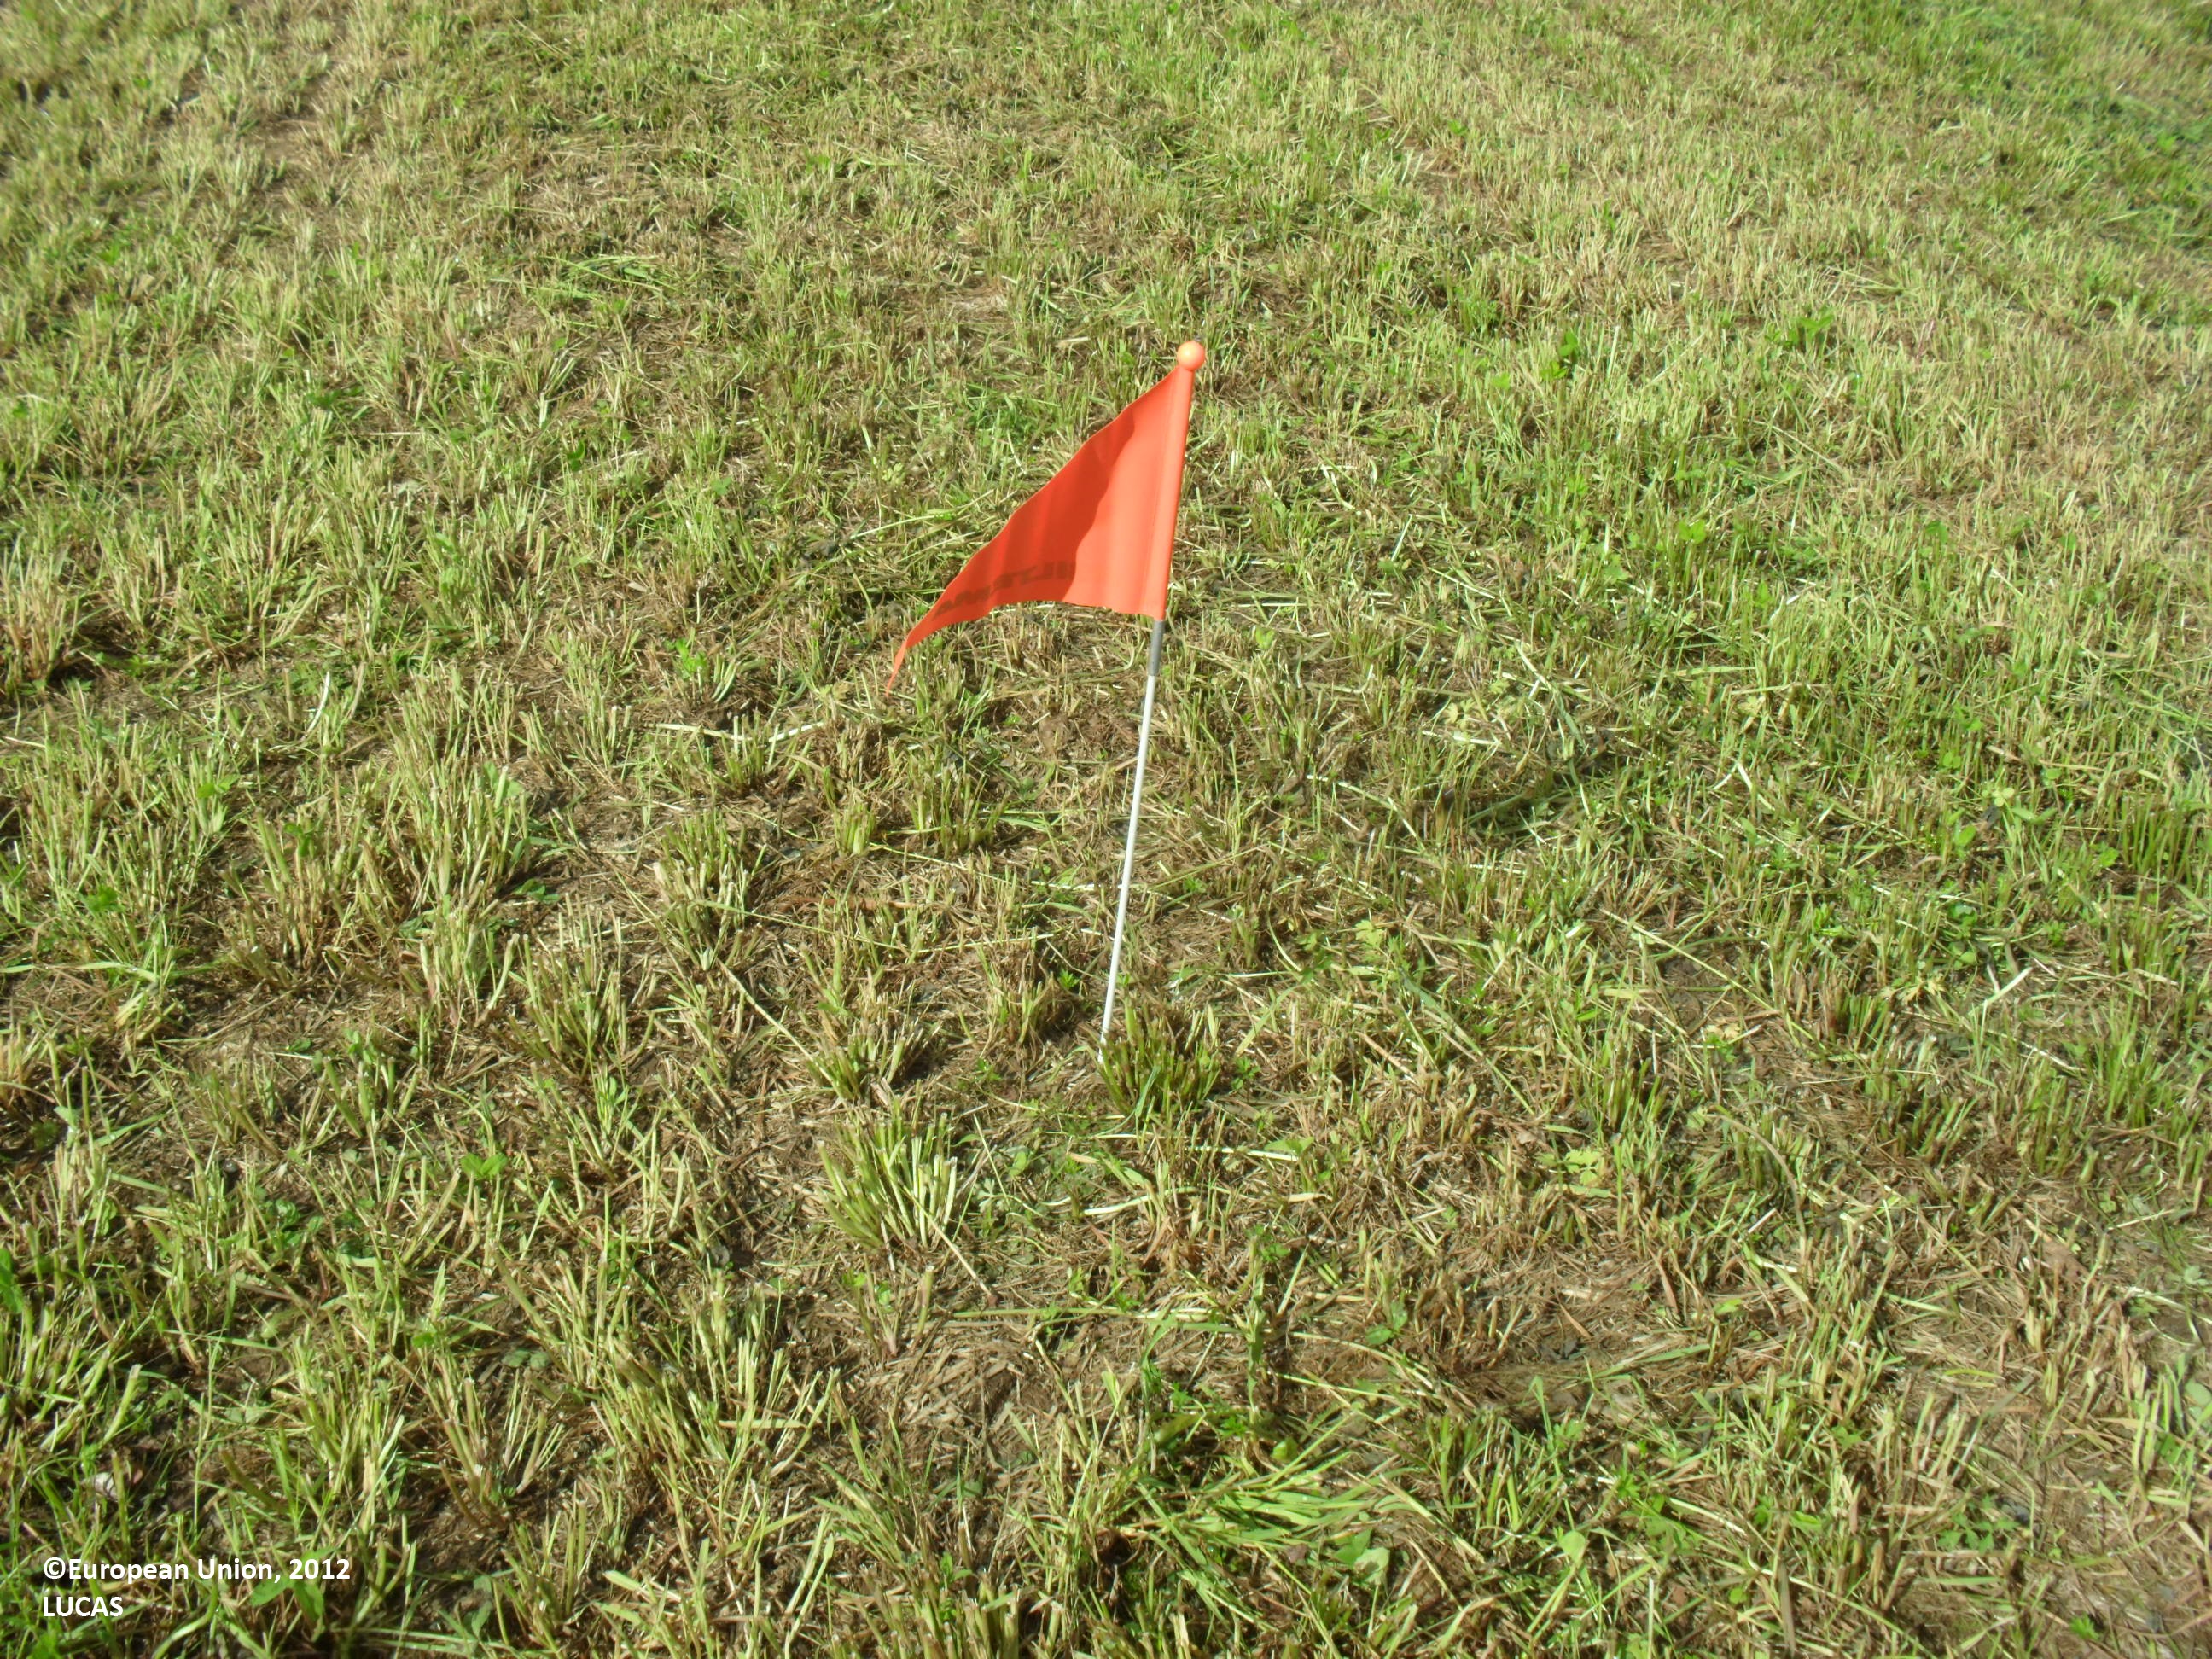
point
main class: Cropland
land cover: Temporary grasslands
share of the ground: 25 - 50 %
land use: Agriculture (excluding fallow land and kitchen gardens)
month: June
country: FI
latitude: 63.1274
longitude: 23.2081
